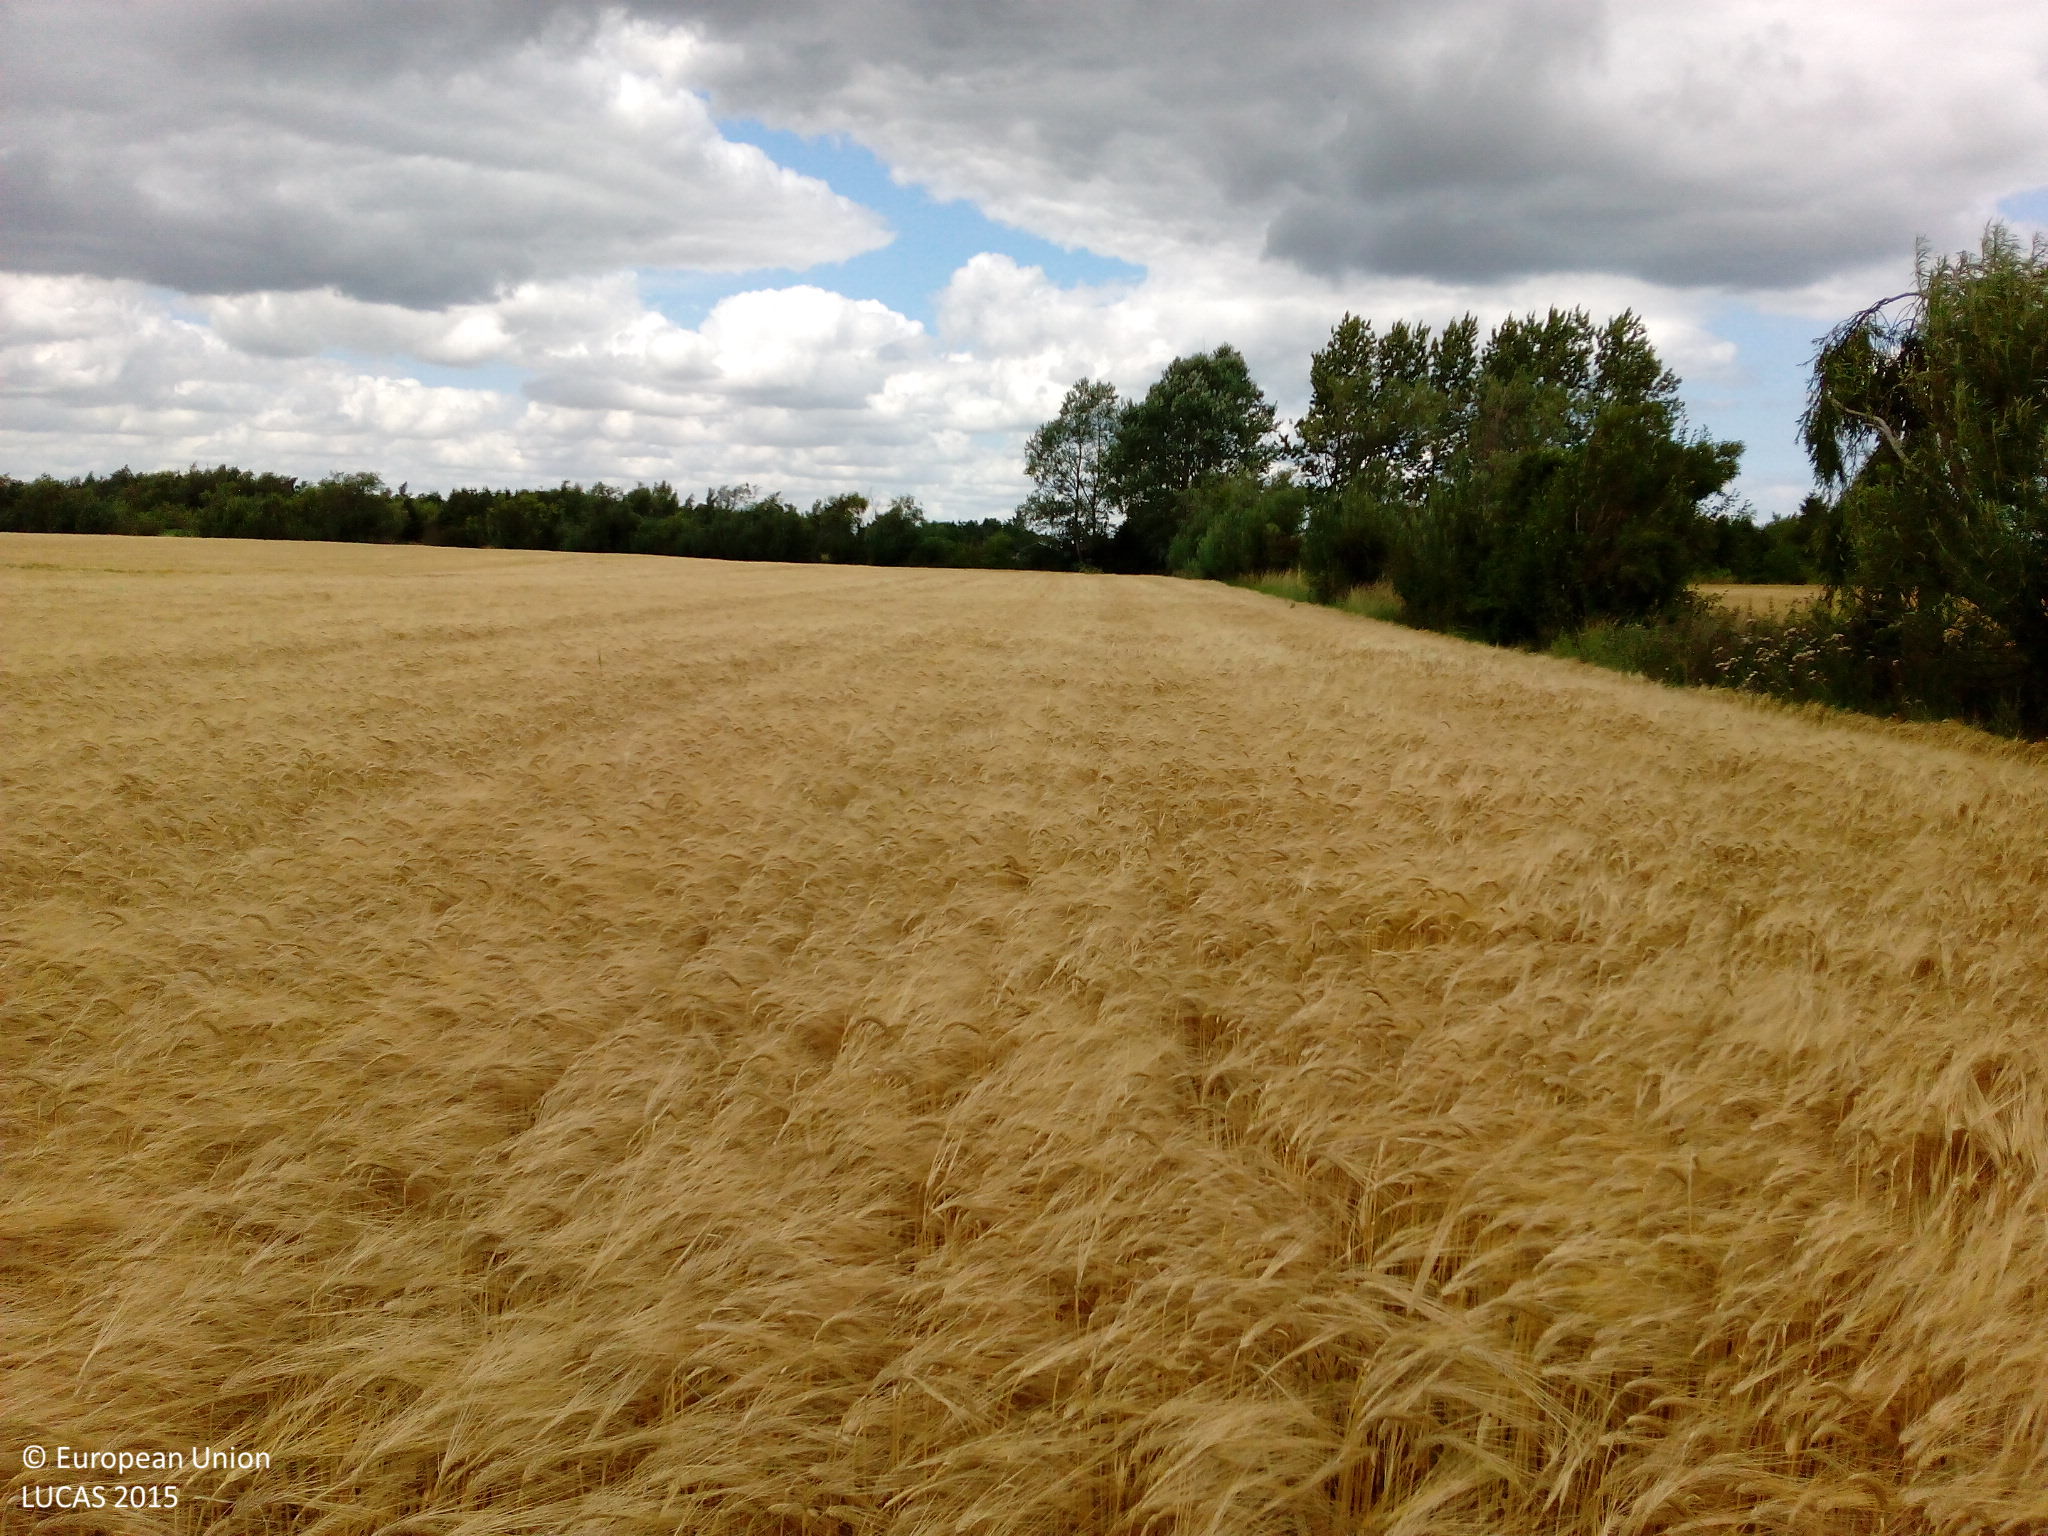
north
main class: Cropland
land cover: Barley
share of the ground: > 75 %
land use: Agriculture (excluding fallow land and kitchen gardens)
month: August
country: DK
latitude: 55.3419
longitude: 12.1901
